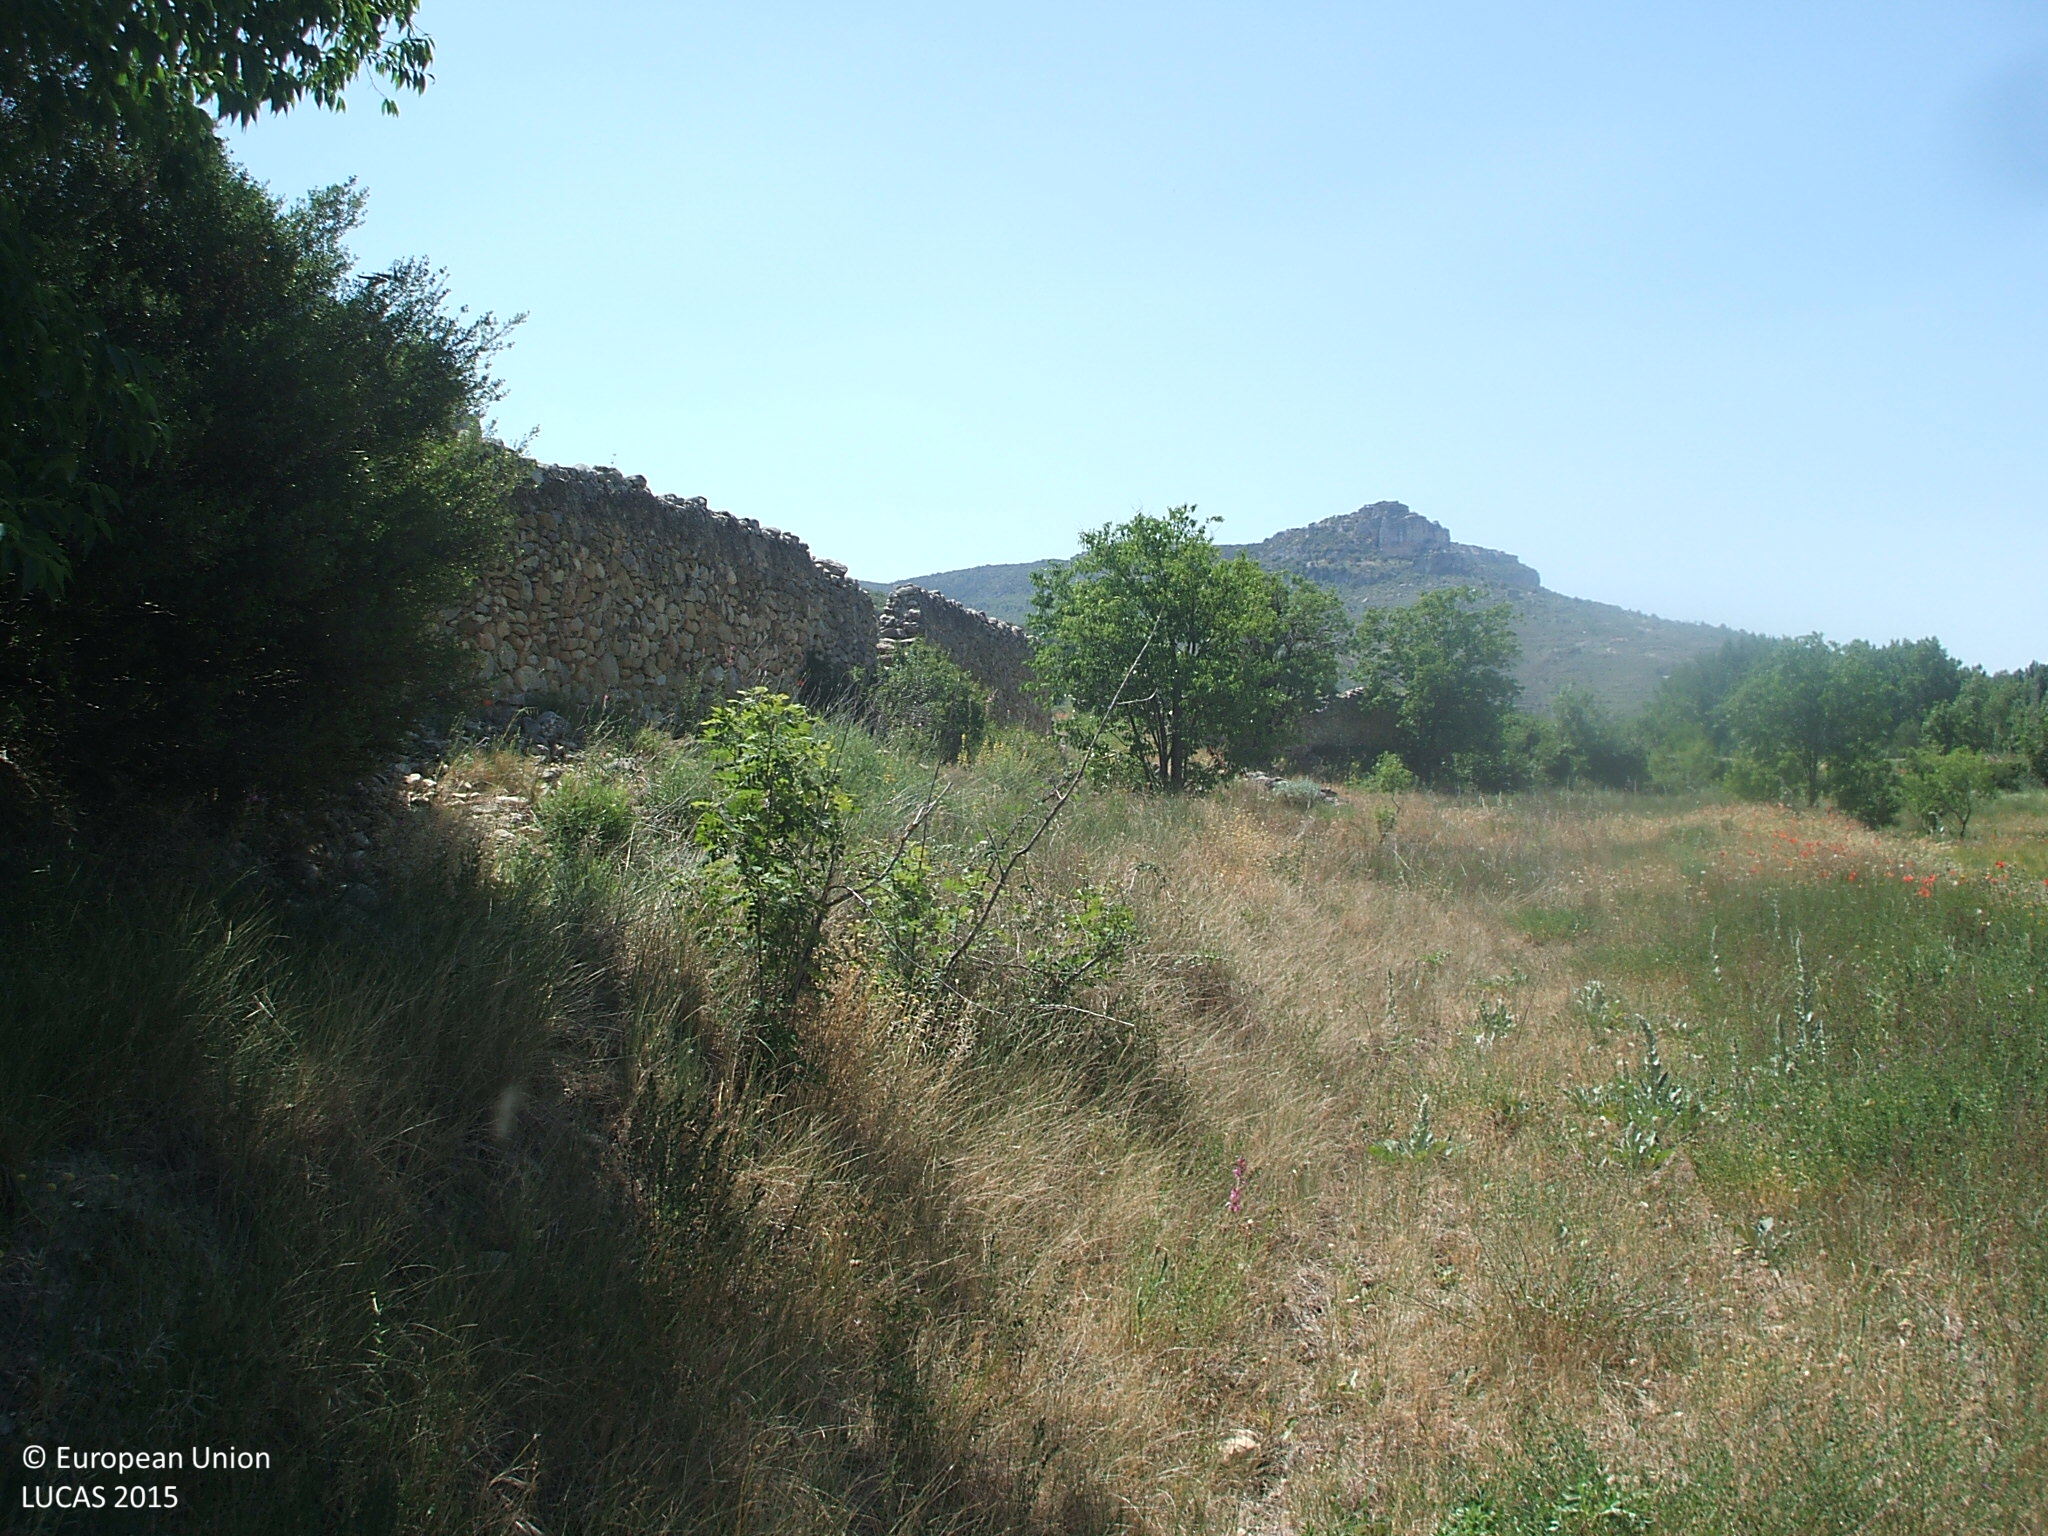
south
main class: Grassland
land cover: Spontaneously vegetated surfaces
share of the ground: > 75 %
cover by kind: herbaceous plants 100 %
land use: Fallow land
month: May
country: ES
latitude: 40.6643
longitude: -0.1927
